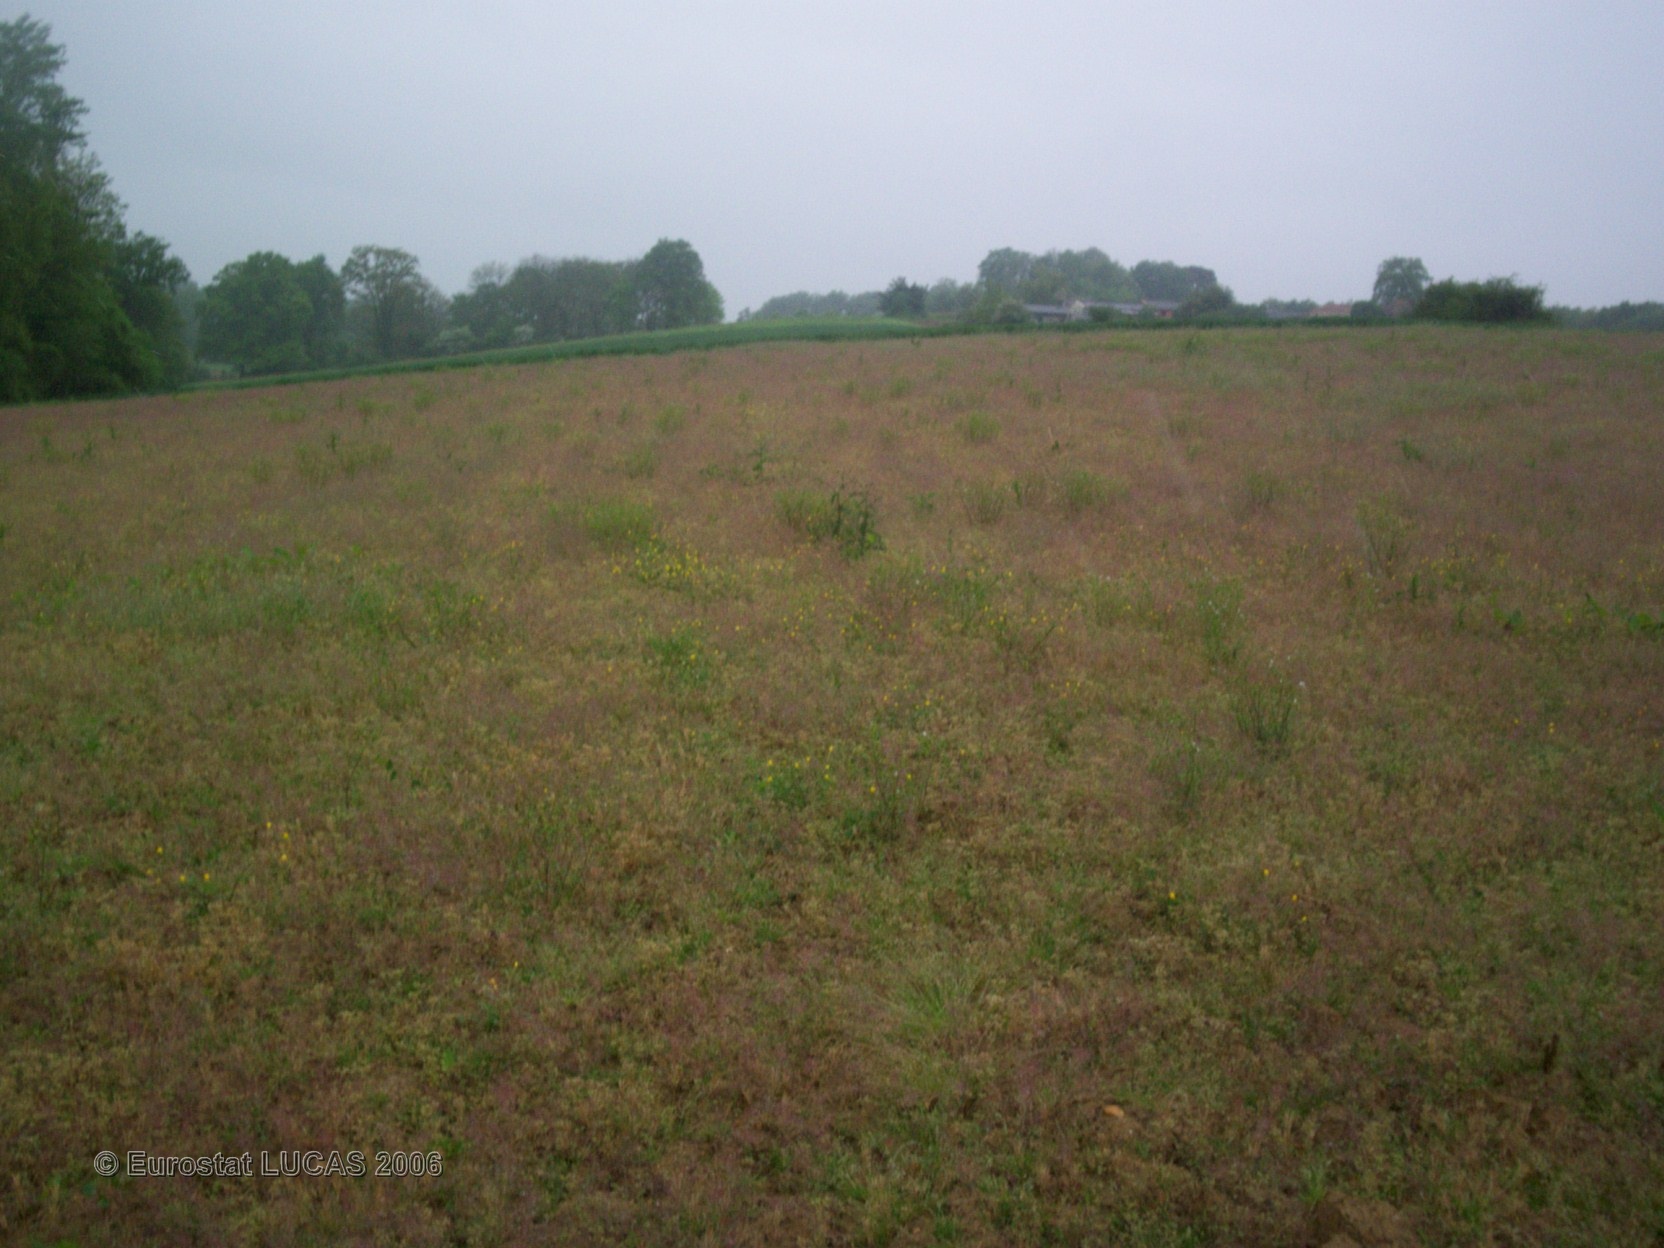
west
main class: Grassland
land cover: Grassland without tree/shrub cover
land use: Fallow land
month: April
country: FR
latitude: 43.5952
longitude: -0.3518
